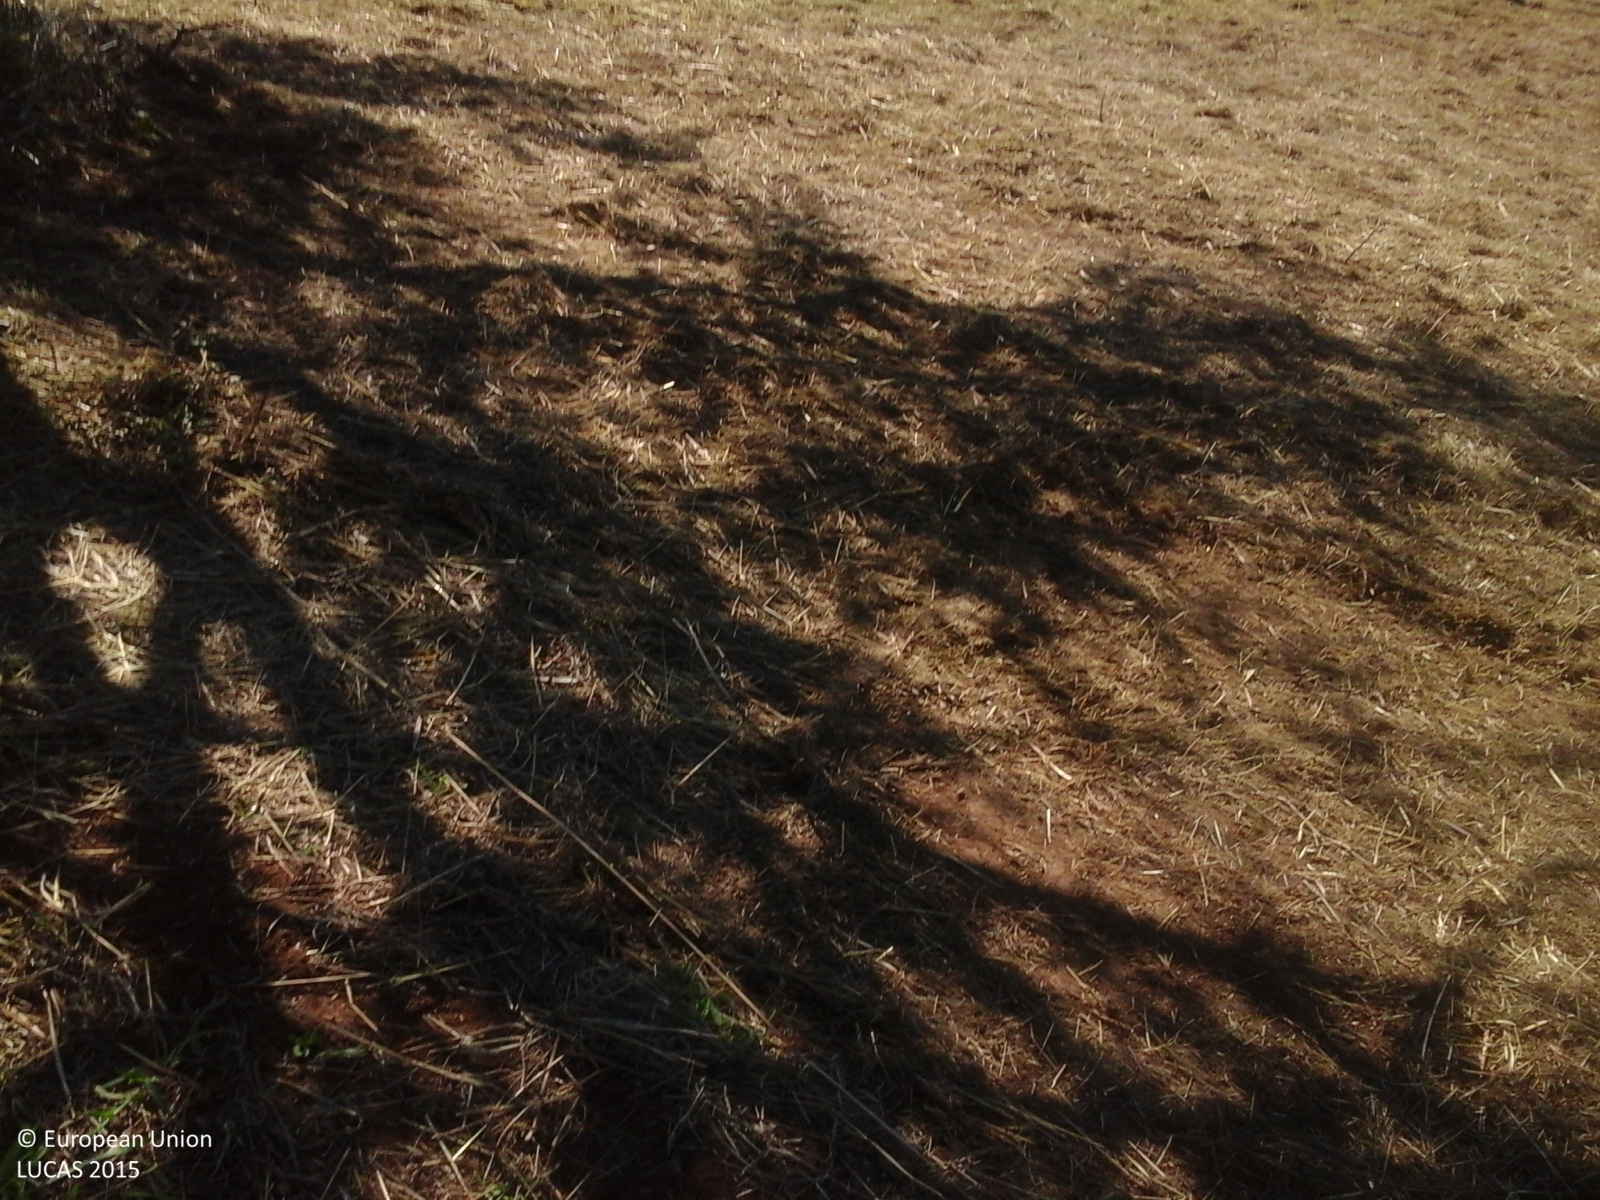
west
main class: Cropland
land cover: Vineyards
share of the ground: 50 - 75 %
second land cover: Olive groves
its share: 50 - 75 %
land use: Agriculture (excluding fallow land and kitchen gardens)
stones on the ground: < 10 %
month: August
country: IT
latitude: 41.8923
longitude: 12.7979
